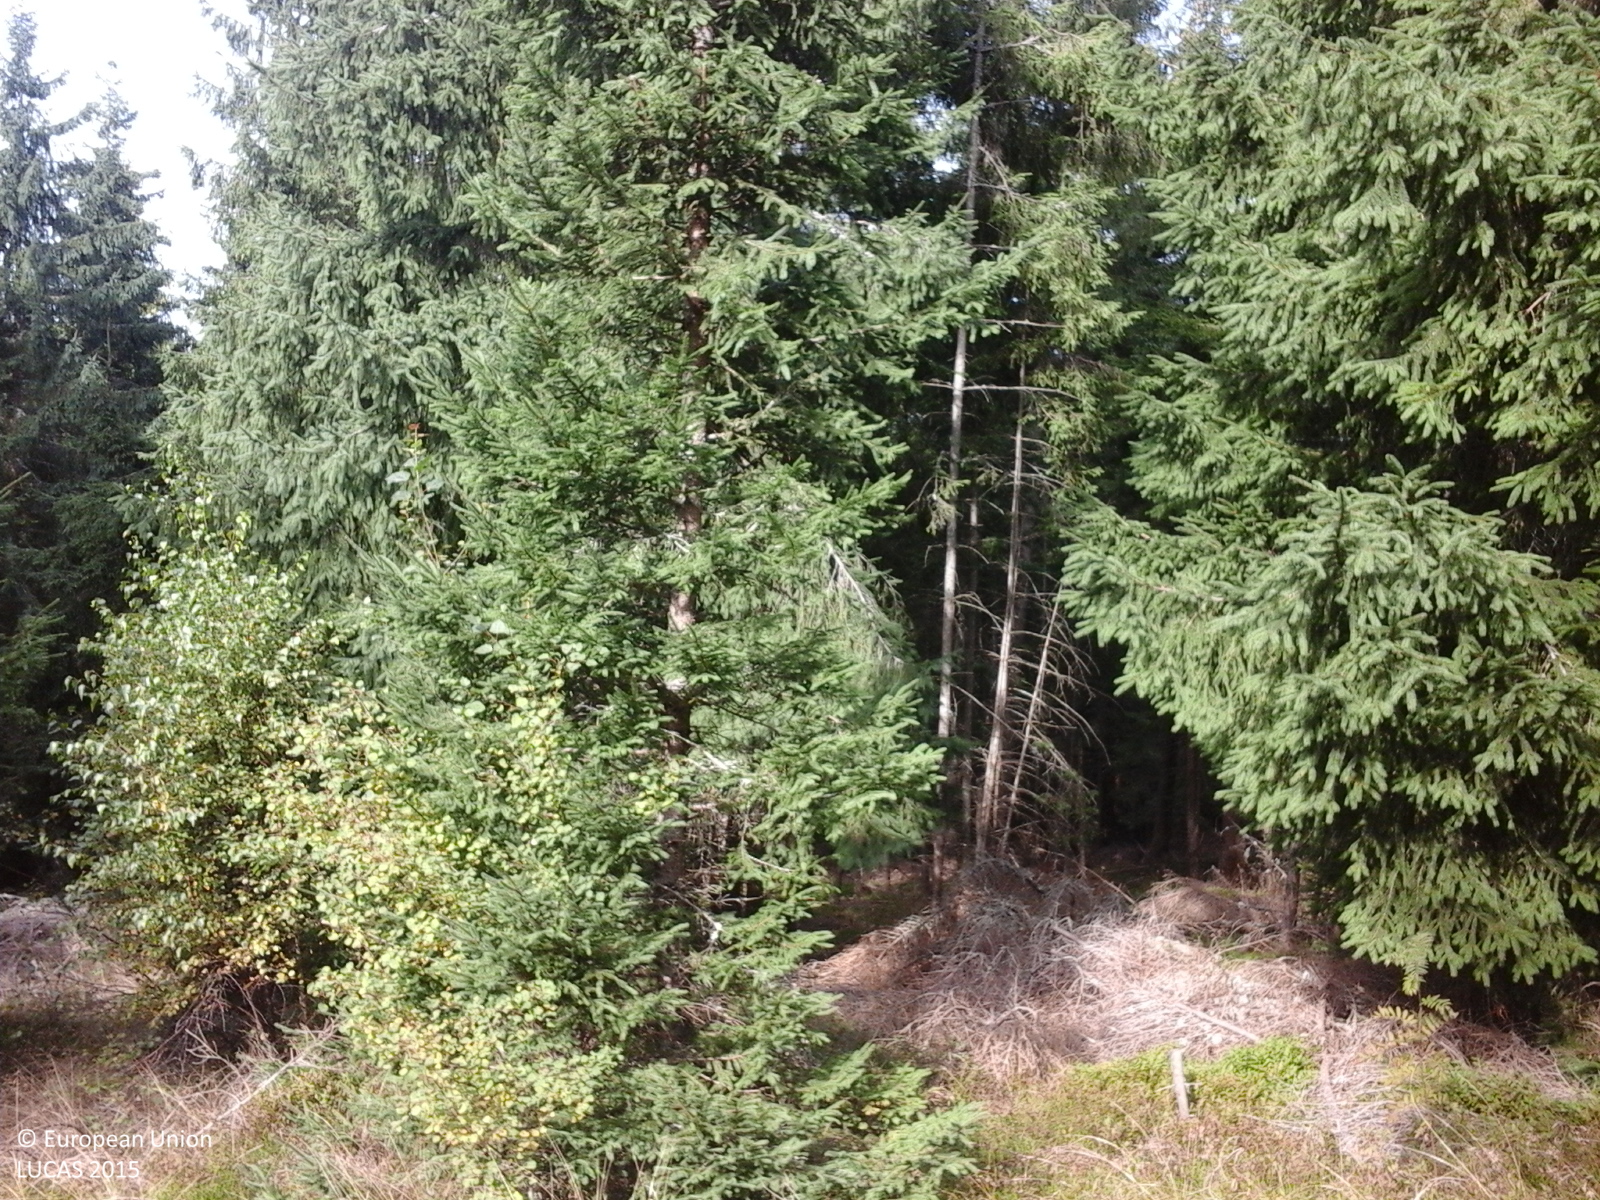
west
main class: Woodland
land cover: Spruce dominated coniferous woodland
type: alpine coniferous forest
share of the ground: > 75 %
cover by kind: coniferous forest trees 75 %, herbaceous plants 15 %, broadleaved forest trees 10 %
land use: Forestry
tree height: > 5 m
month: September
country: RO
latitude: 46.6936
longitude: 23.0729
